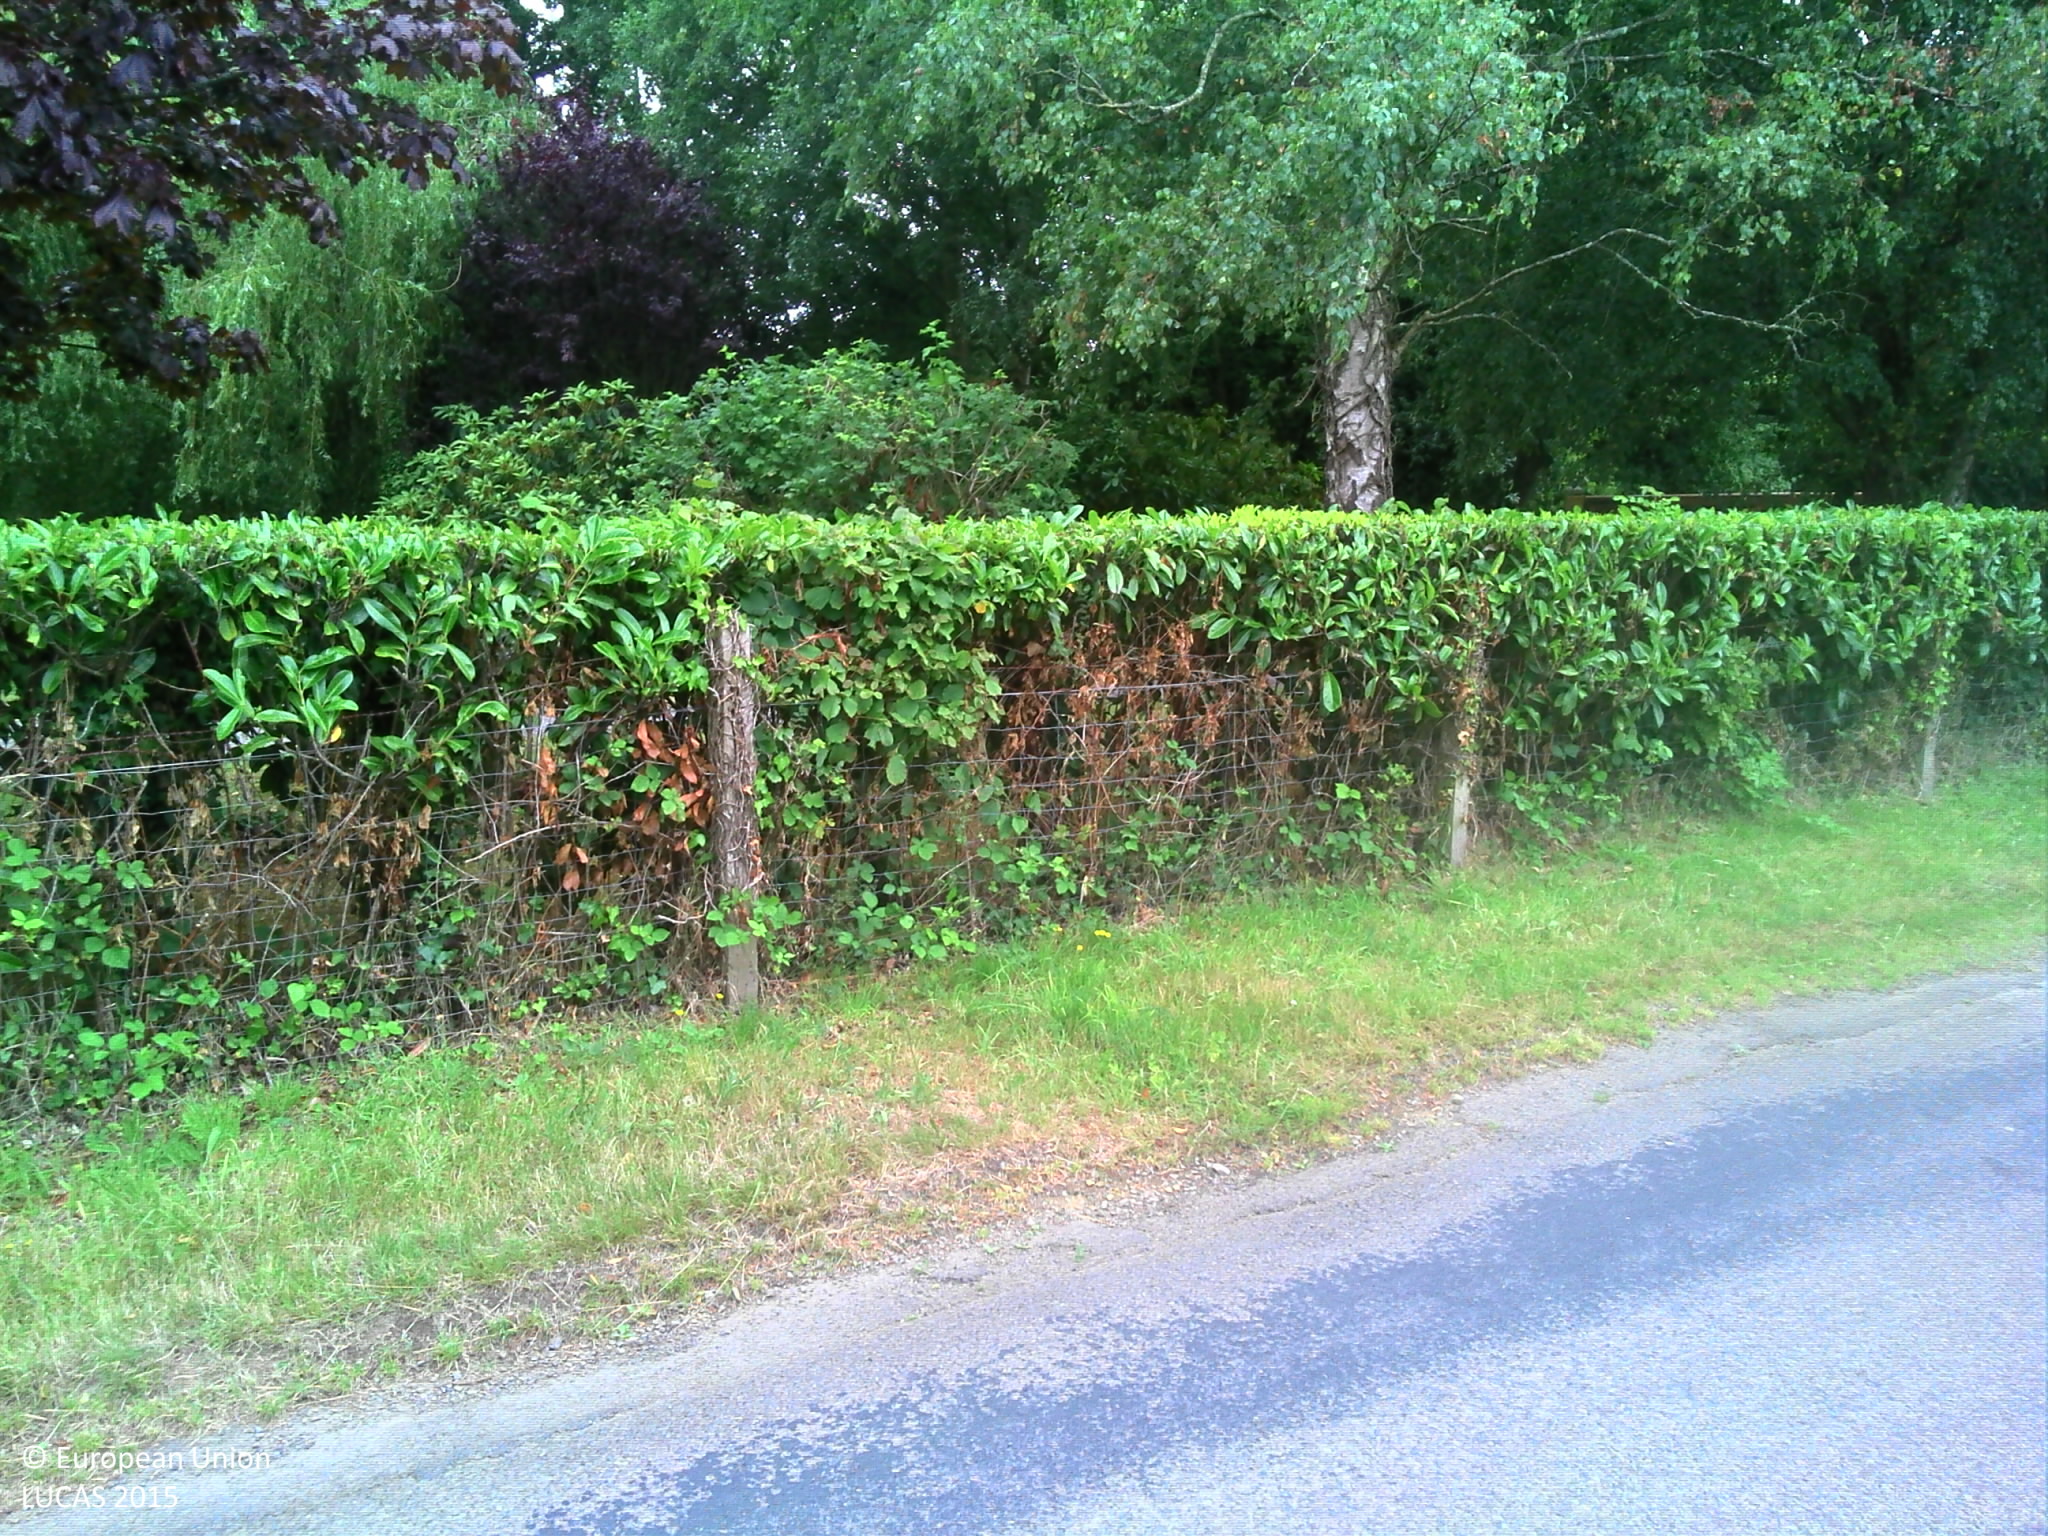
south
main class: Grassland
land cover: Grassland without tree/shrub cover
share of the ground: > 75 %
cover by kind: herbaceous plants 100 %
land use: Agriculture (excluding fallow land and kitchen gardens)
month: July
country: FR
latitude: 48.7599
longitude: -1.5433
